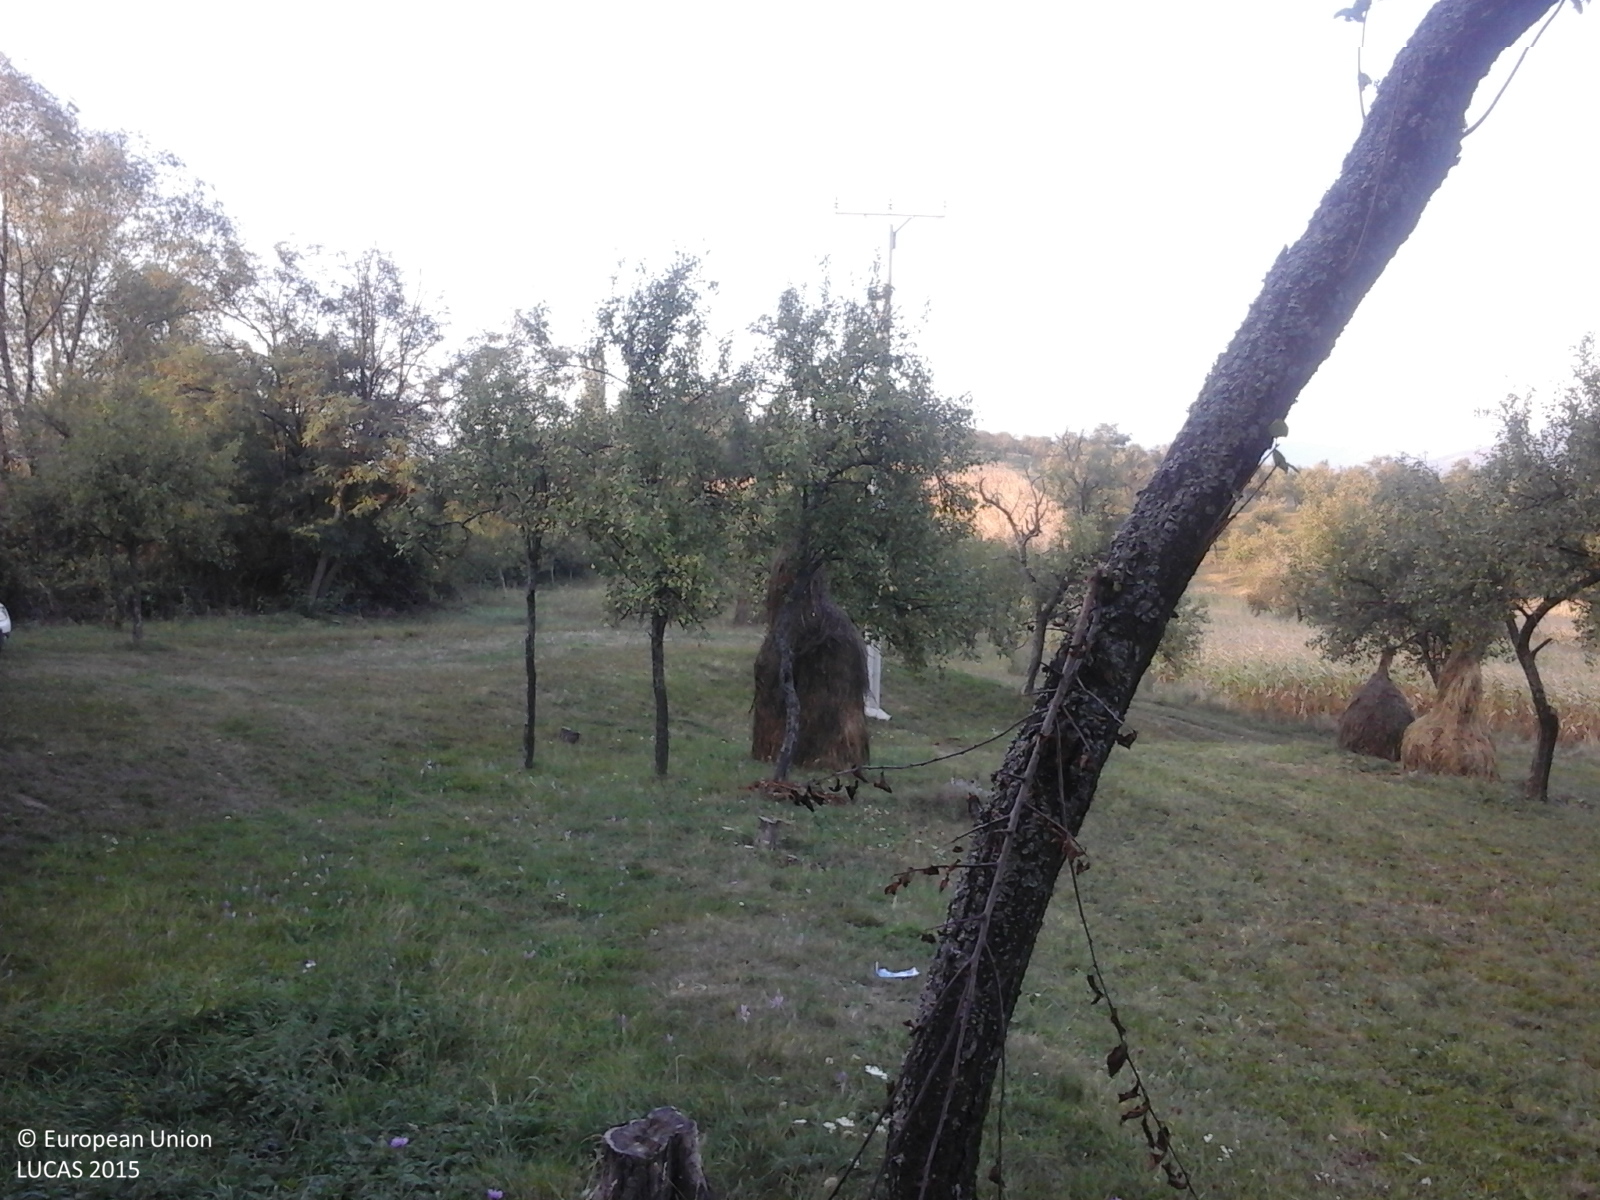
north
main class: Cropland
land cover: Other fruit trees and berries
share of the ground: > 75 %
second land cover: Grassland without tree/shrub cover
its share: > 75 %
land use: Agriculture (excluding fallow land and kitchen gardens)
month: September
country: RO
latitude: 45.1301
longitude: 22.2841
